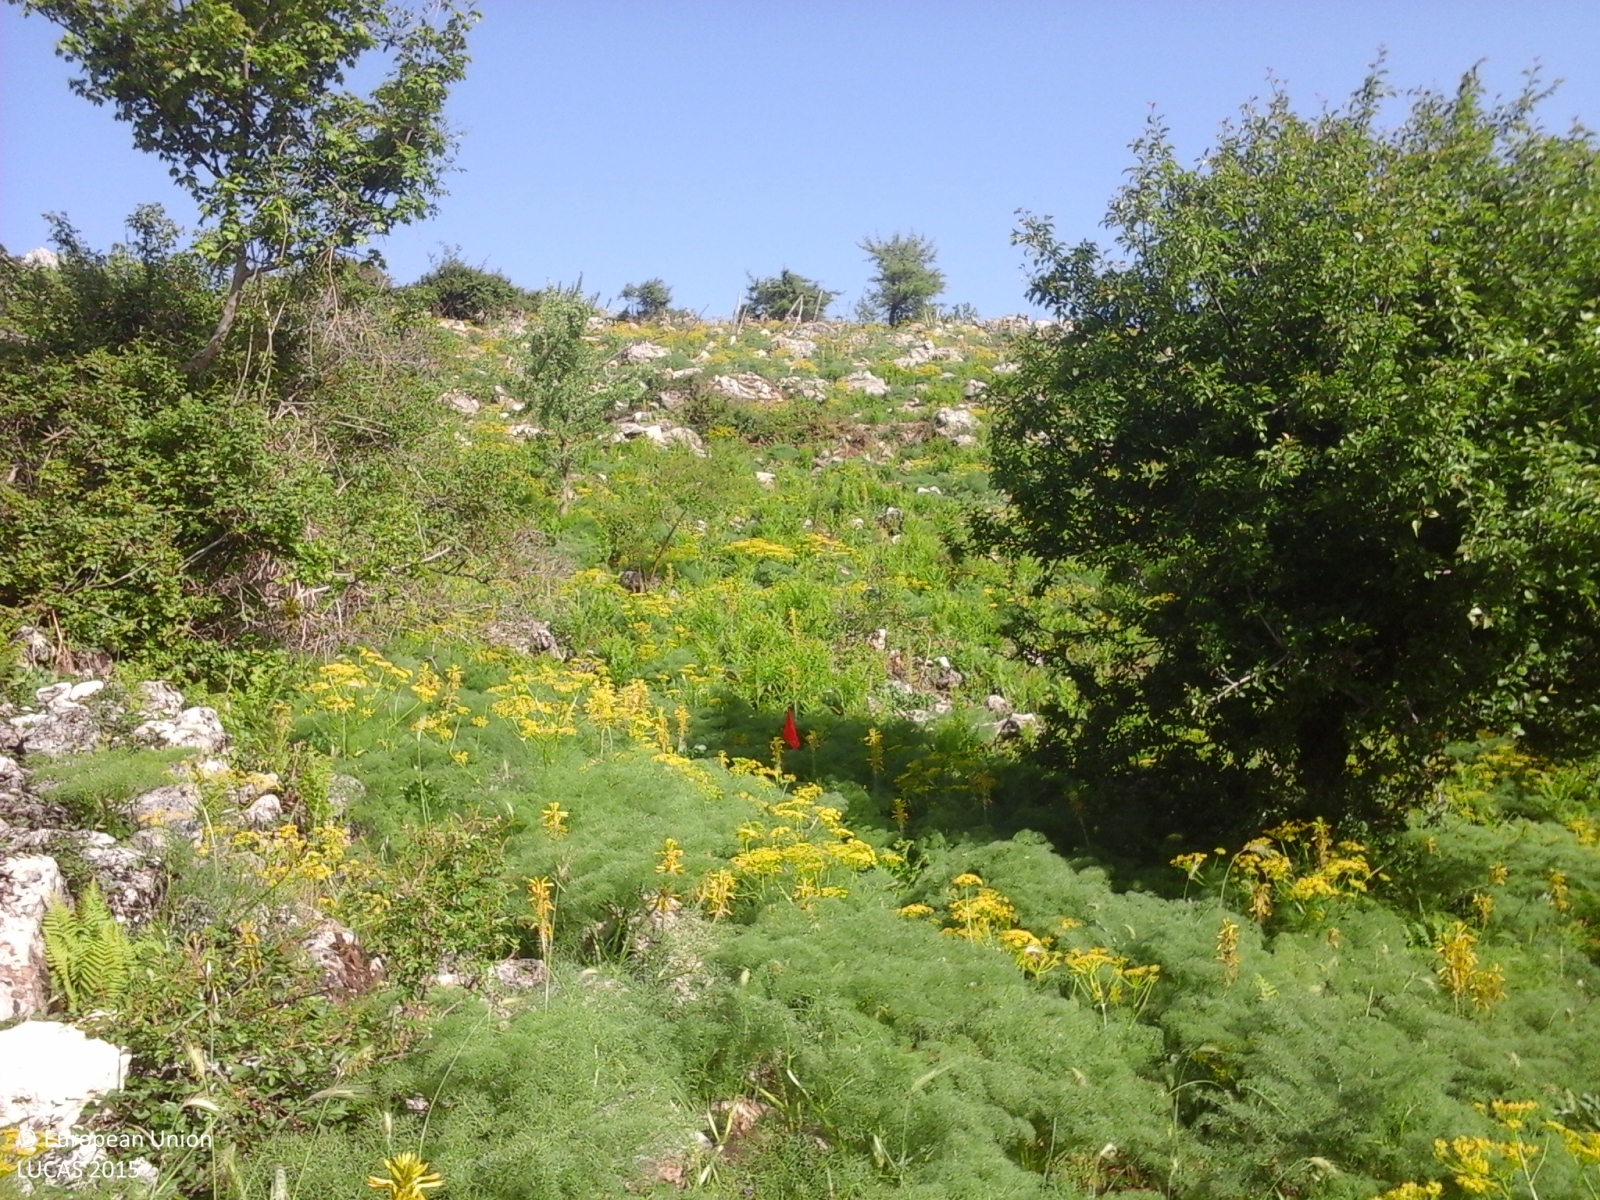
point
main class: Grassland
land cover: Grassland with sparse tree/shrub cover
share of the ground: > 75 %
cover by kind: herbaceous plants 70 %, consolidated bare surface 15 %, shrubs 10 %, broadleaved forest trees 5 %
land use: Agriculture (excluding fallow land and kitchen gardens)
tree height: < 5 m
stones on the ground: 25 - 50 %
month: May
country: IT
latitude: 37.8611
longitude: 14.0519
